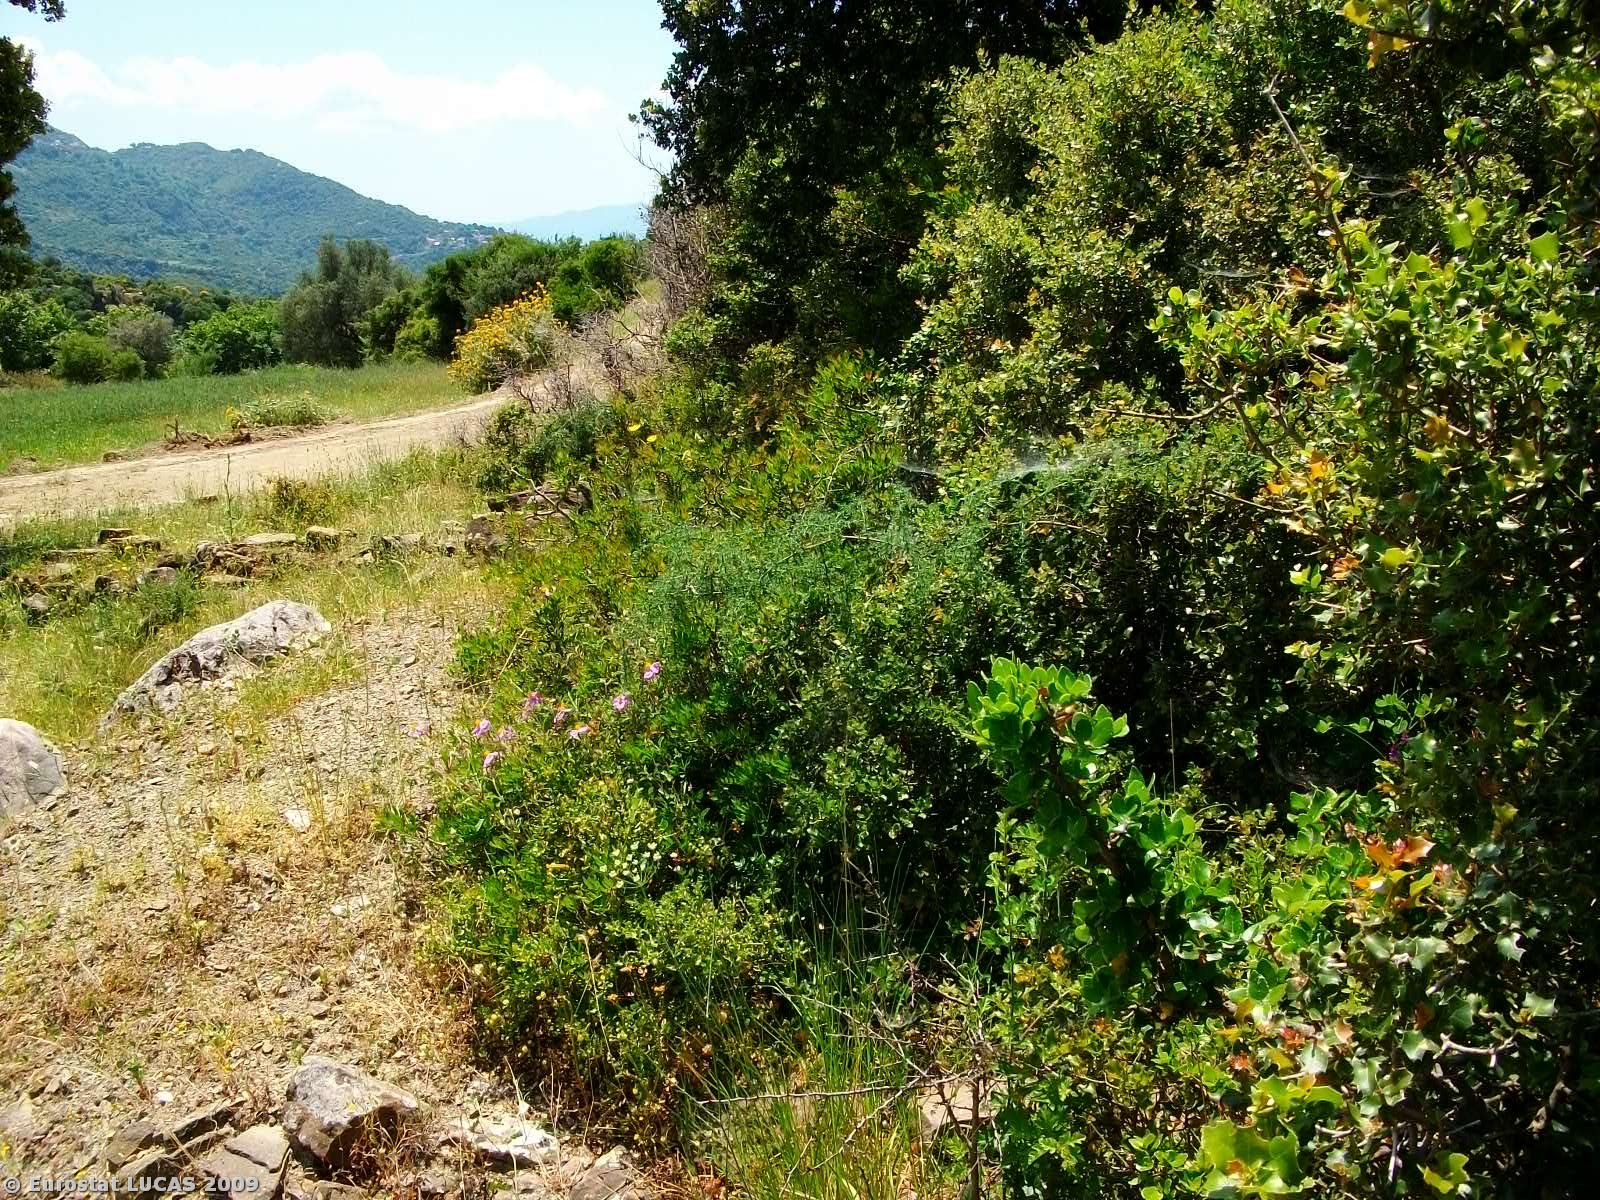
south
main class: Shrubland
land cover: Shrubland with sparse tree cover
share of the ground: > 75 %
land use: Agriculture (excluding fallow land and kitchen gardens)
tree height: > 5 m
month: May
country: GR
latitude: 38.6726
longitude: 21.5226
